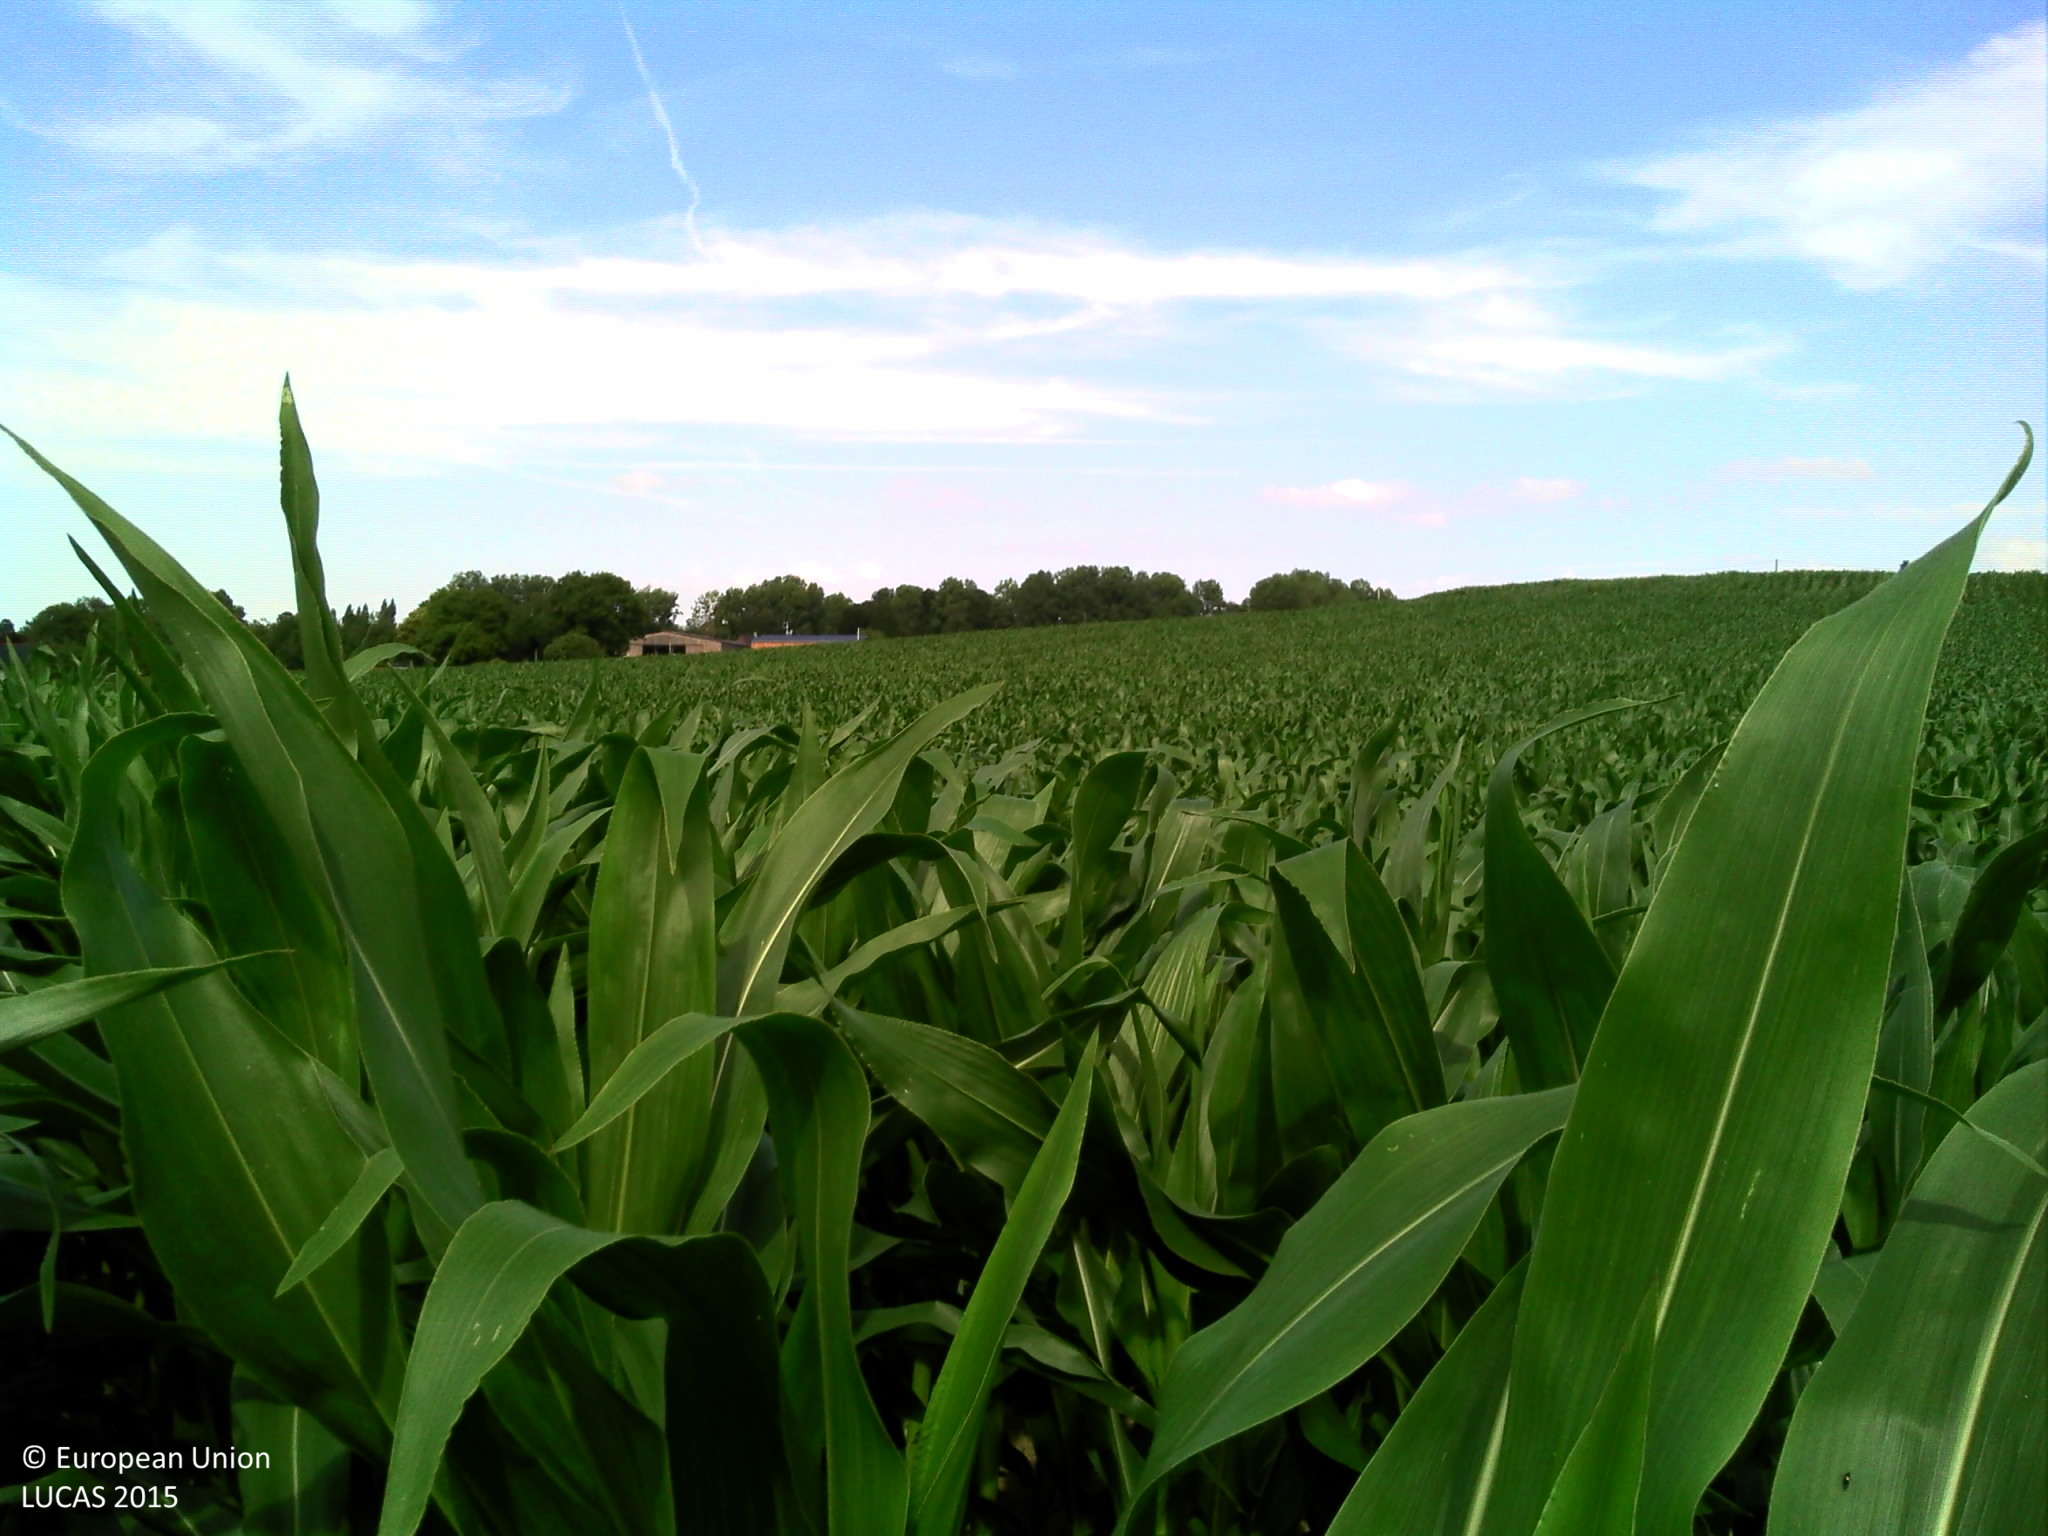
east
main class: Cropland
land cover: Maize
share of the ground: > 75 %
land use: Agriculture (excluding fallow land and kitchen gardens)
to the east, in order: Maize; Electric lines; Grass margins; Paved roads, cycling and walking lanes; Grass margins; Durum wheat
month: July
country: FR
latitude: 48.4750
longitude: -1.9983
